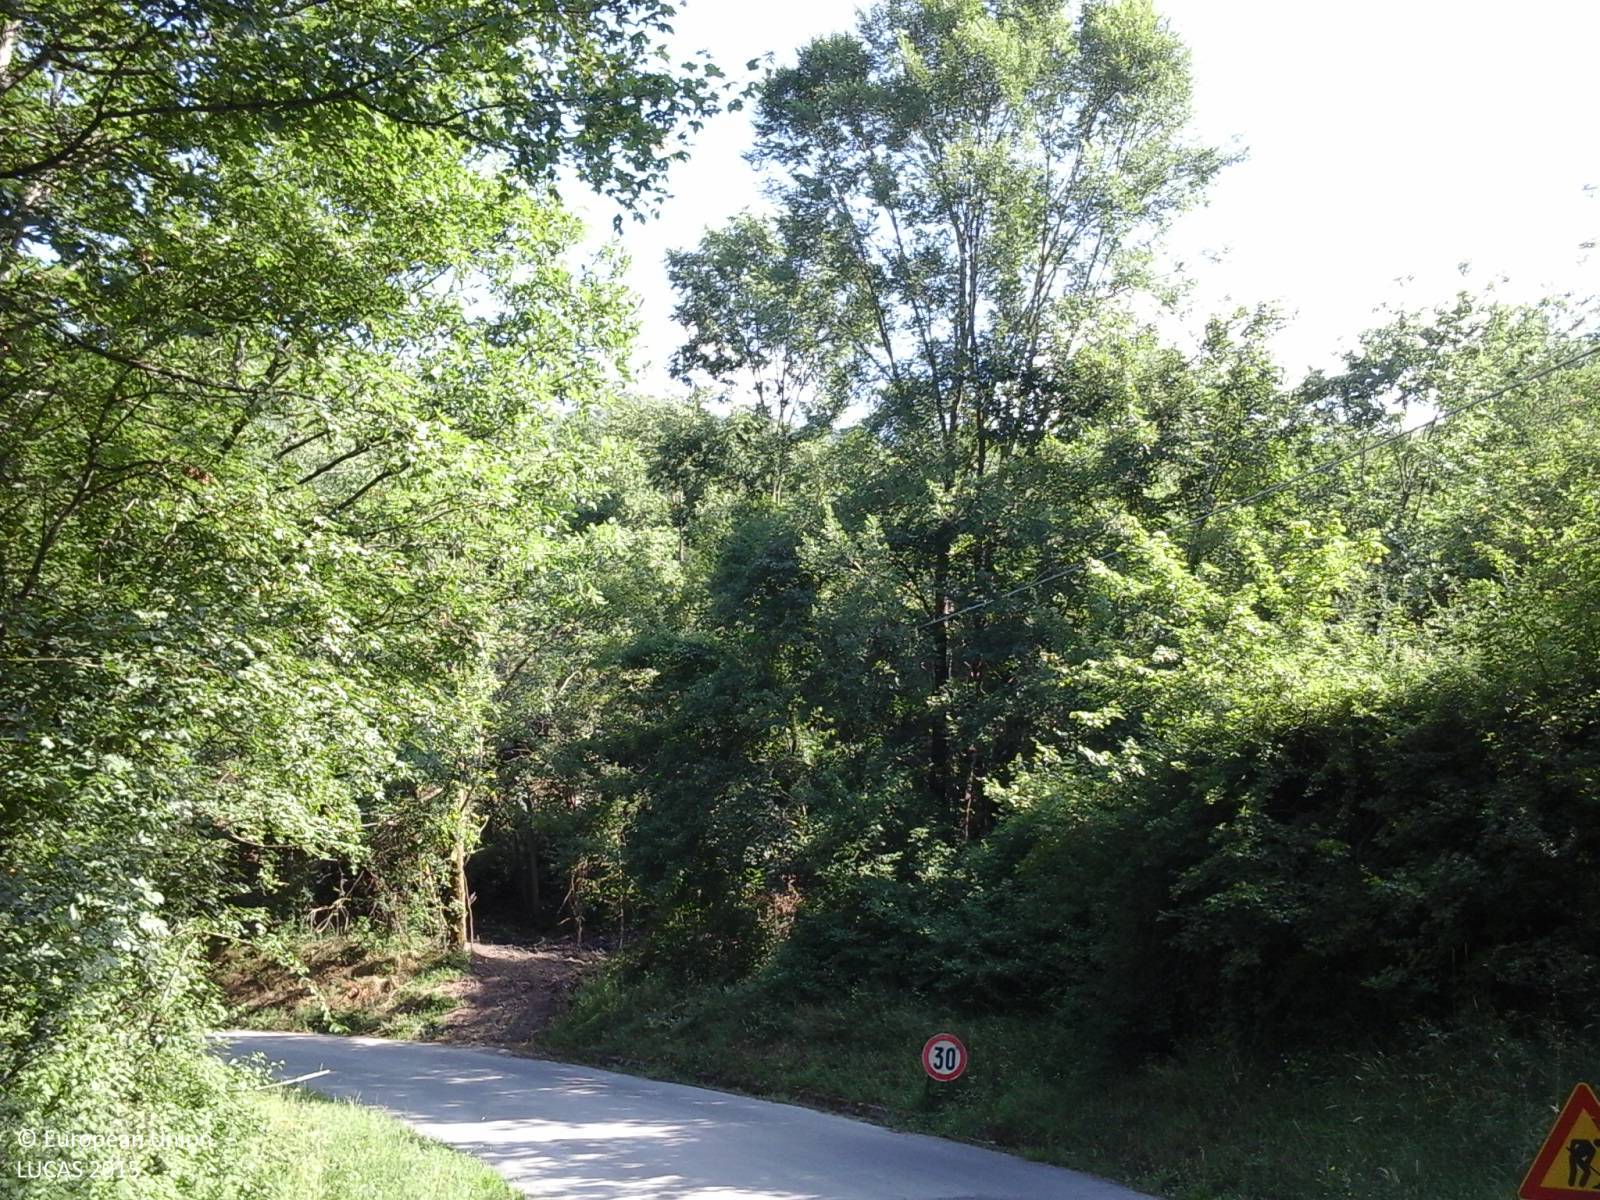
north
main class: Woodland
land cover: Broadleaved woodland
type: thermophilous deciduous forest
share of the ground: > 75 %
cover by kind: broadleaved forest trees 70 %, shrubs 30 %
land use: Forestry
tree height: < 5 m
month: June
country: IT
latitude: 44.0241
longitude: 10.6098
